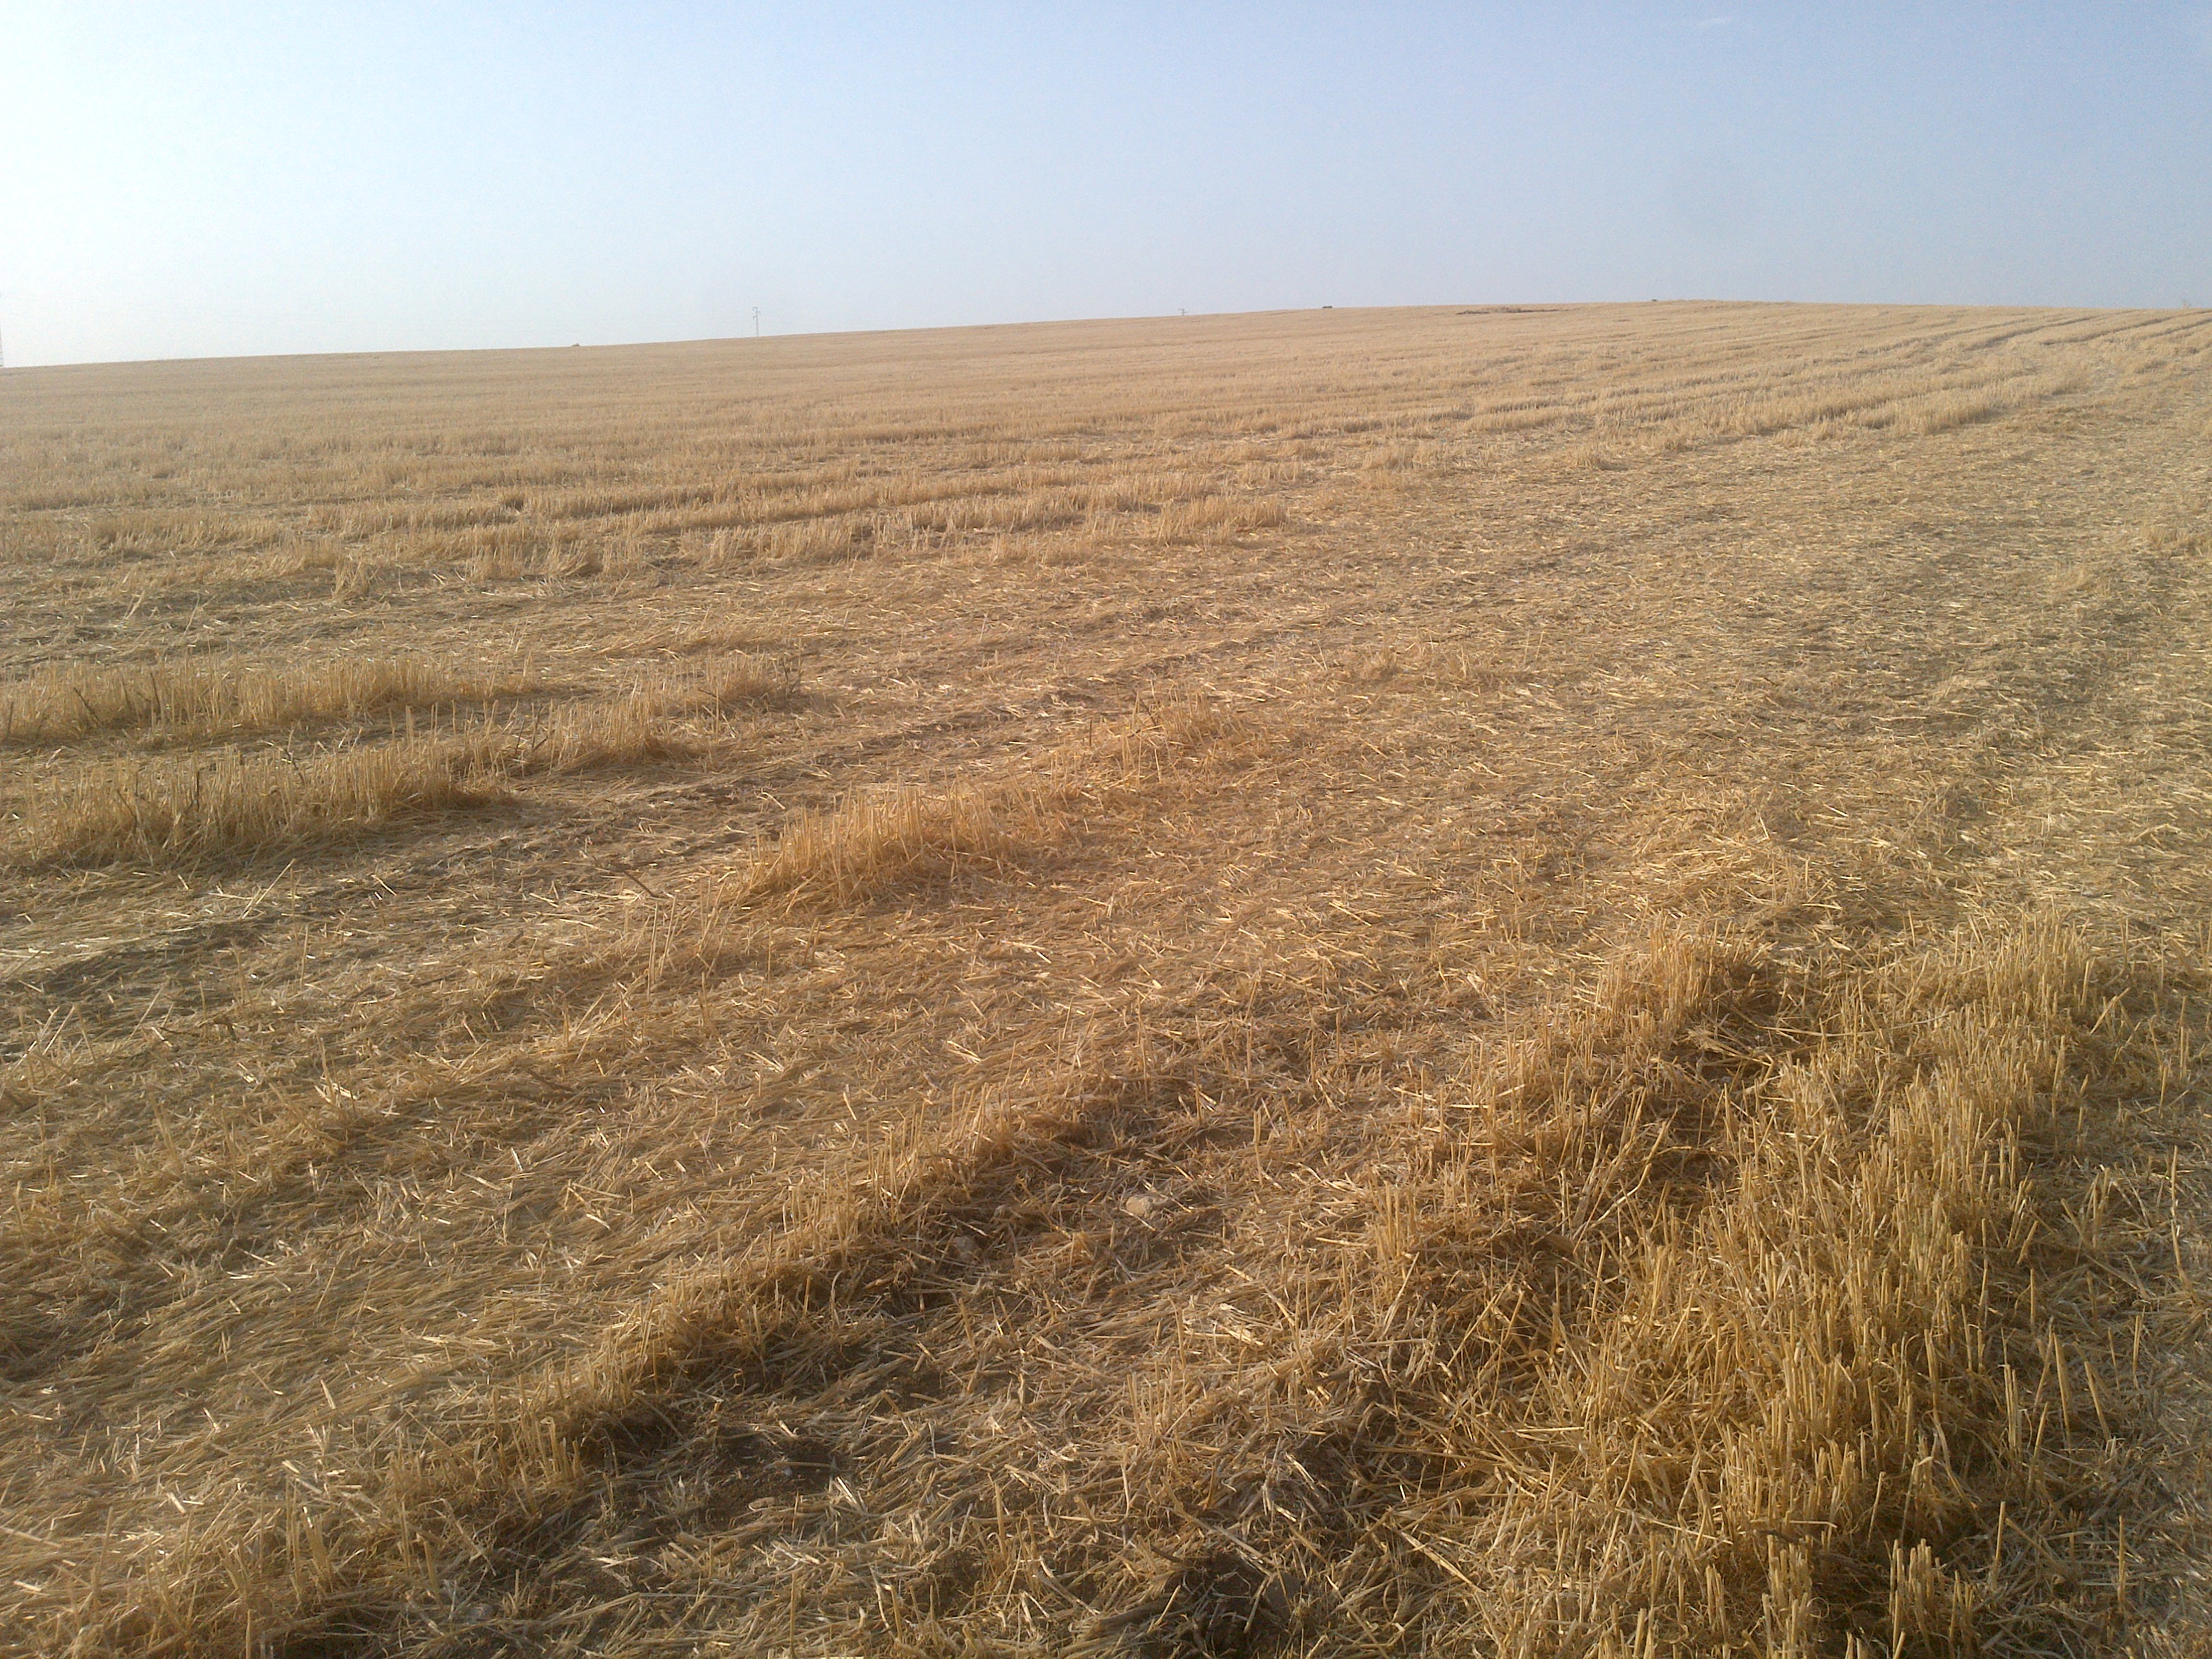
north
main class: Cropland
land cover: Durum wheat
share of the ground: < 10 %
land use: Agriculture (excluding fallow land and kitchen gardens)
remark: Harvested field
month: July
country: ES
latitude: 37.5215
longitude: -4.9115
